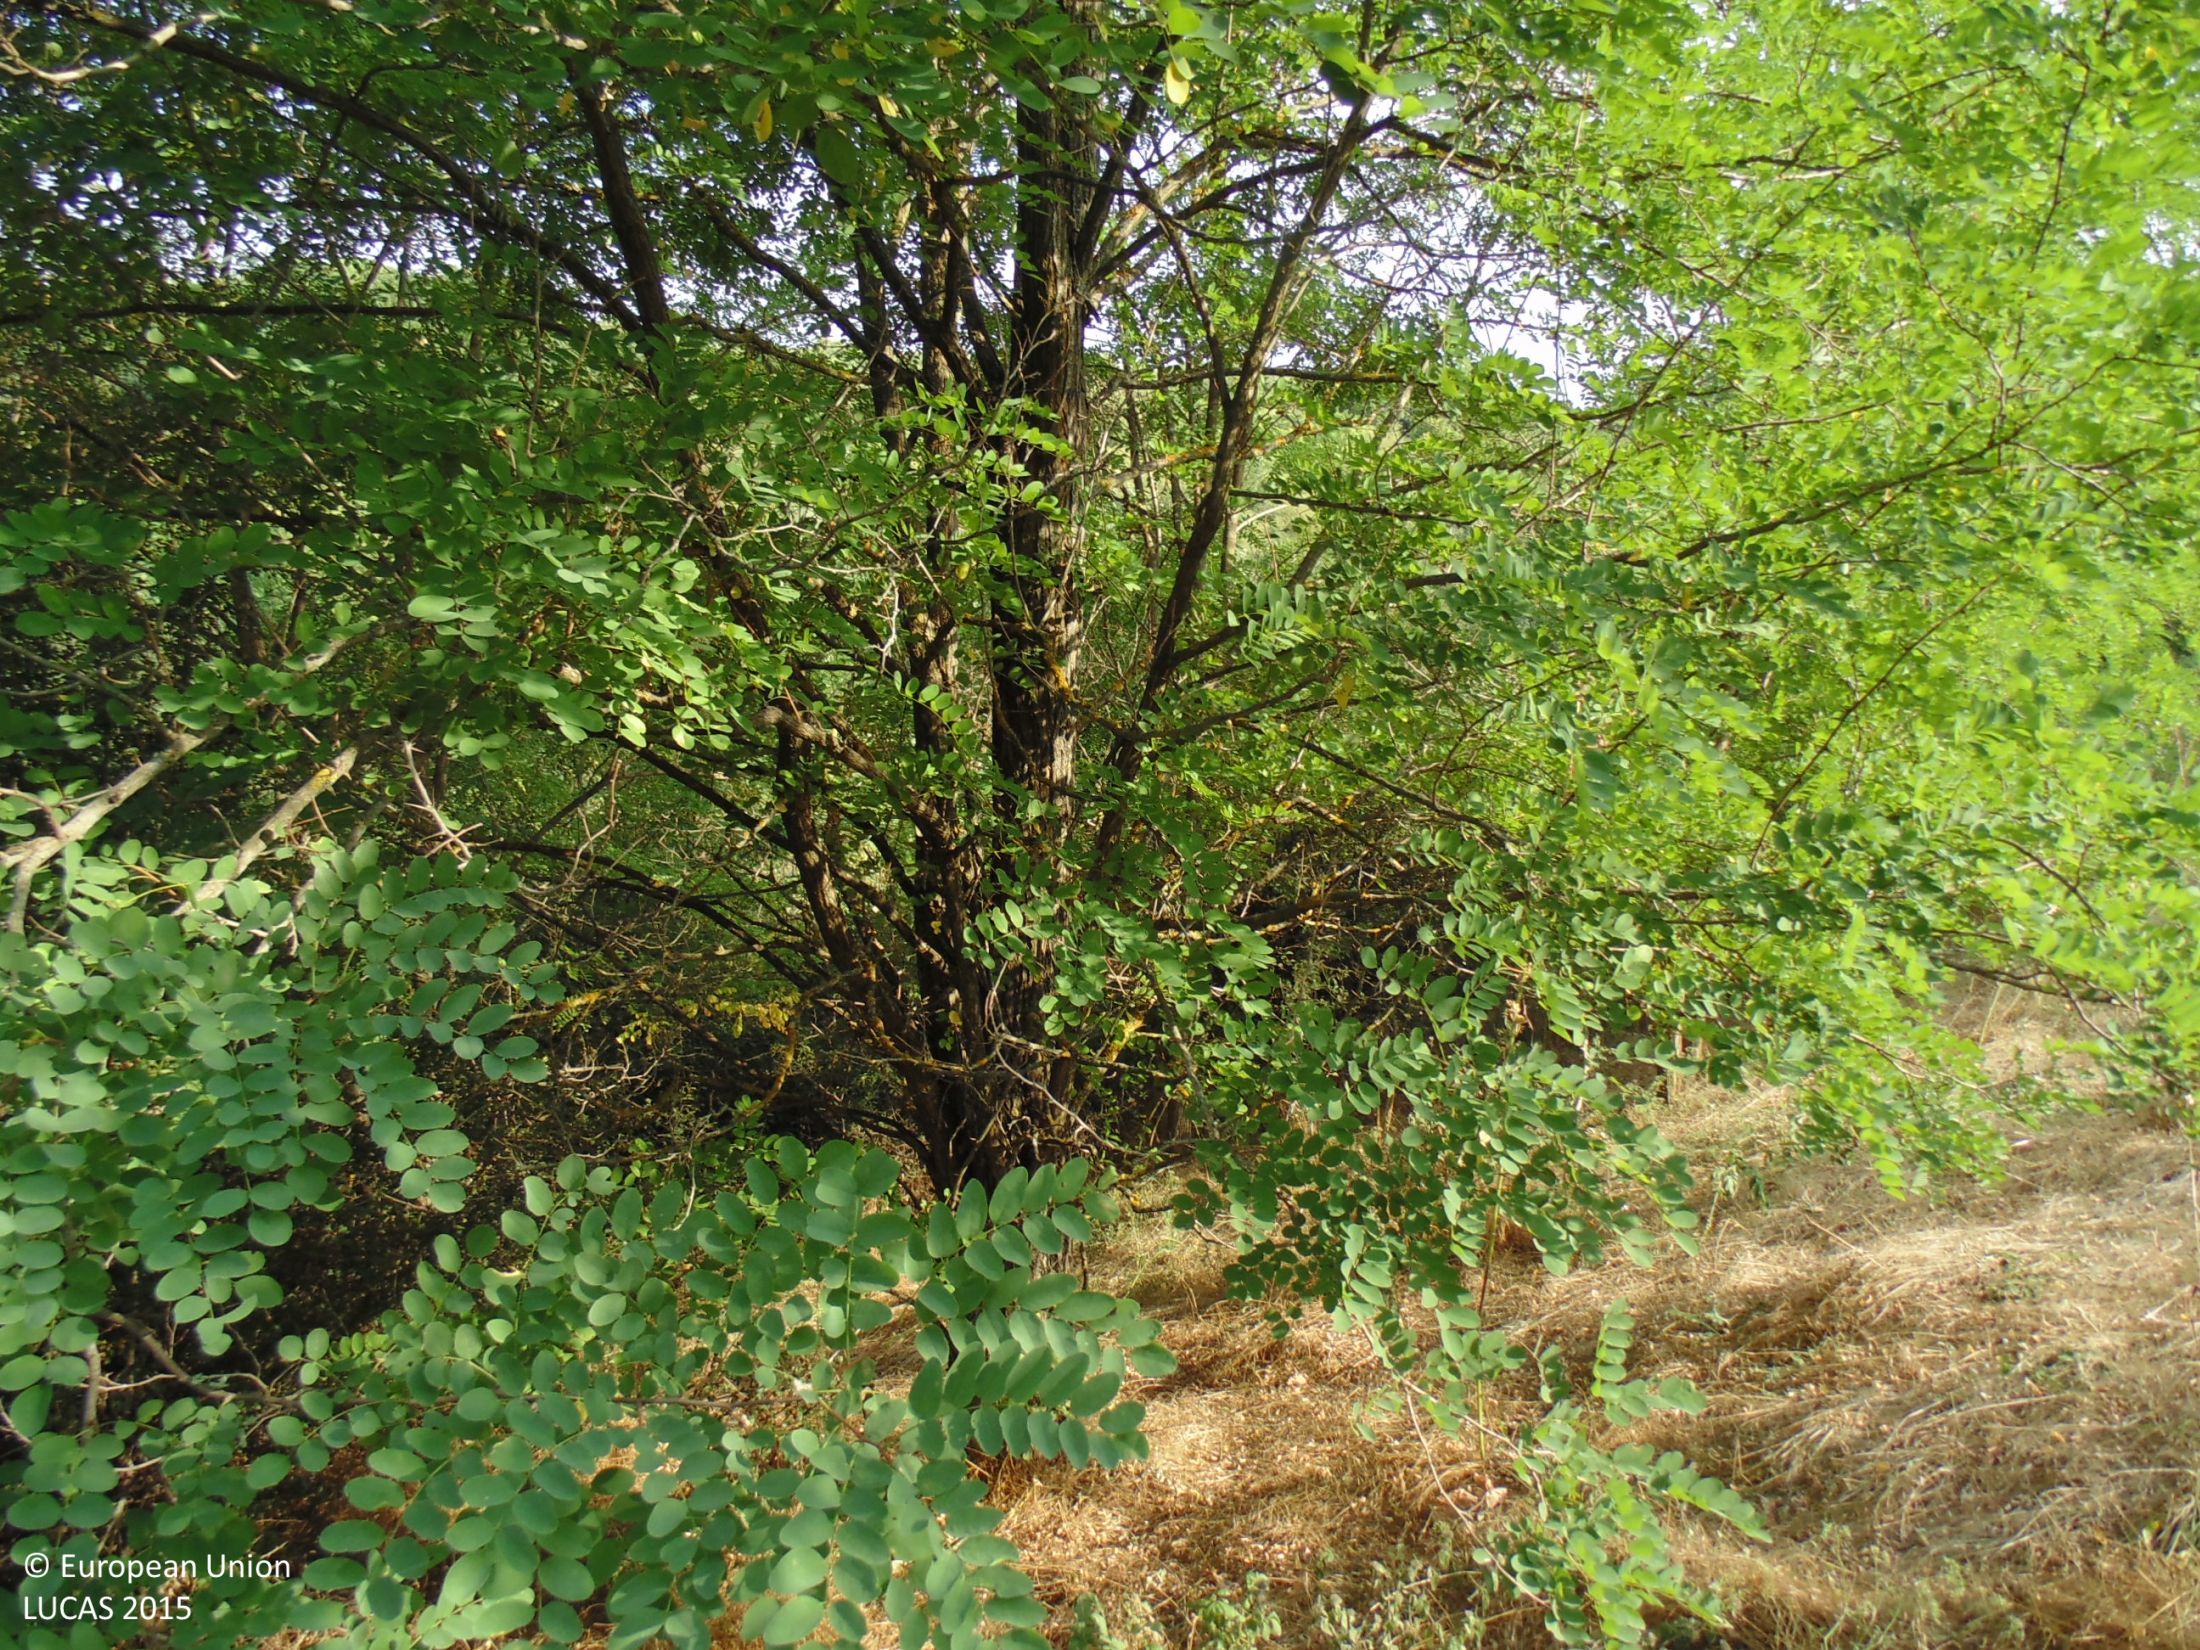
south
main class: Woodland
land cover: Broadleaved woodland
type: mesophytic deciduous forest
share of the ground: 50 - 75 %
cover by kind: broadleaved forest trees 70 %, shrubs 15 %, herbaceous plants 15 %
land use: Semi-natural and natural areas not in use
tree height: > 5 m
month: August
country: BG
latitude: 43.9392
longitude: 27.6956
